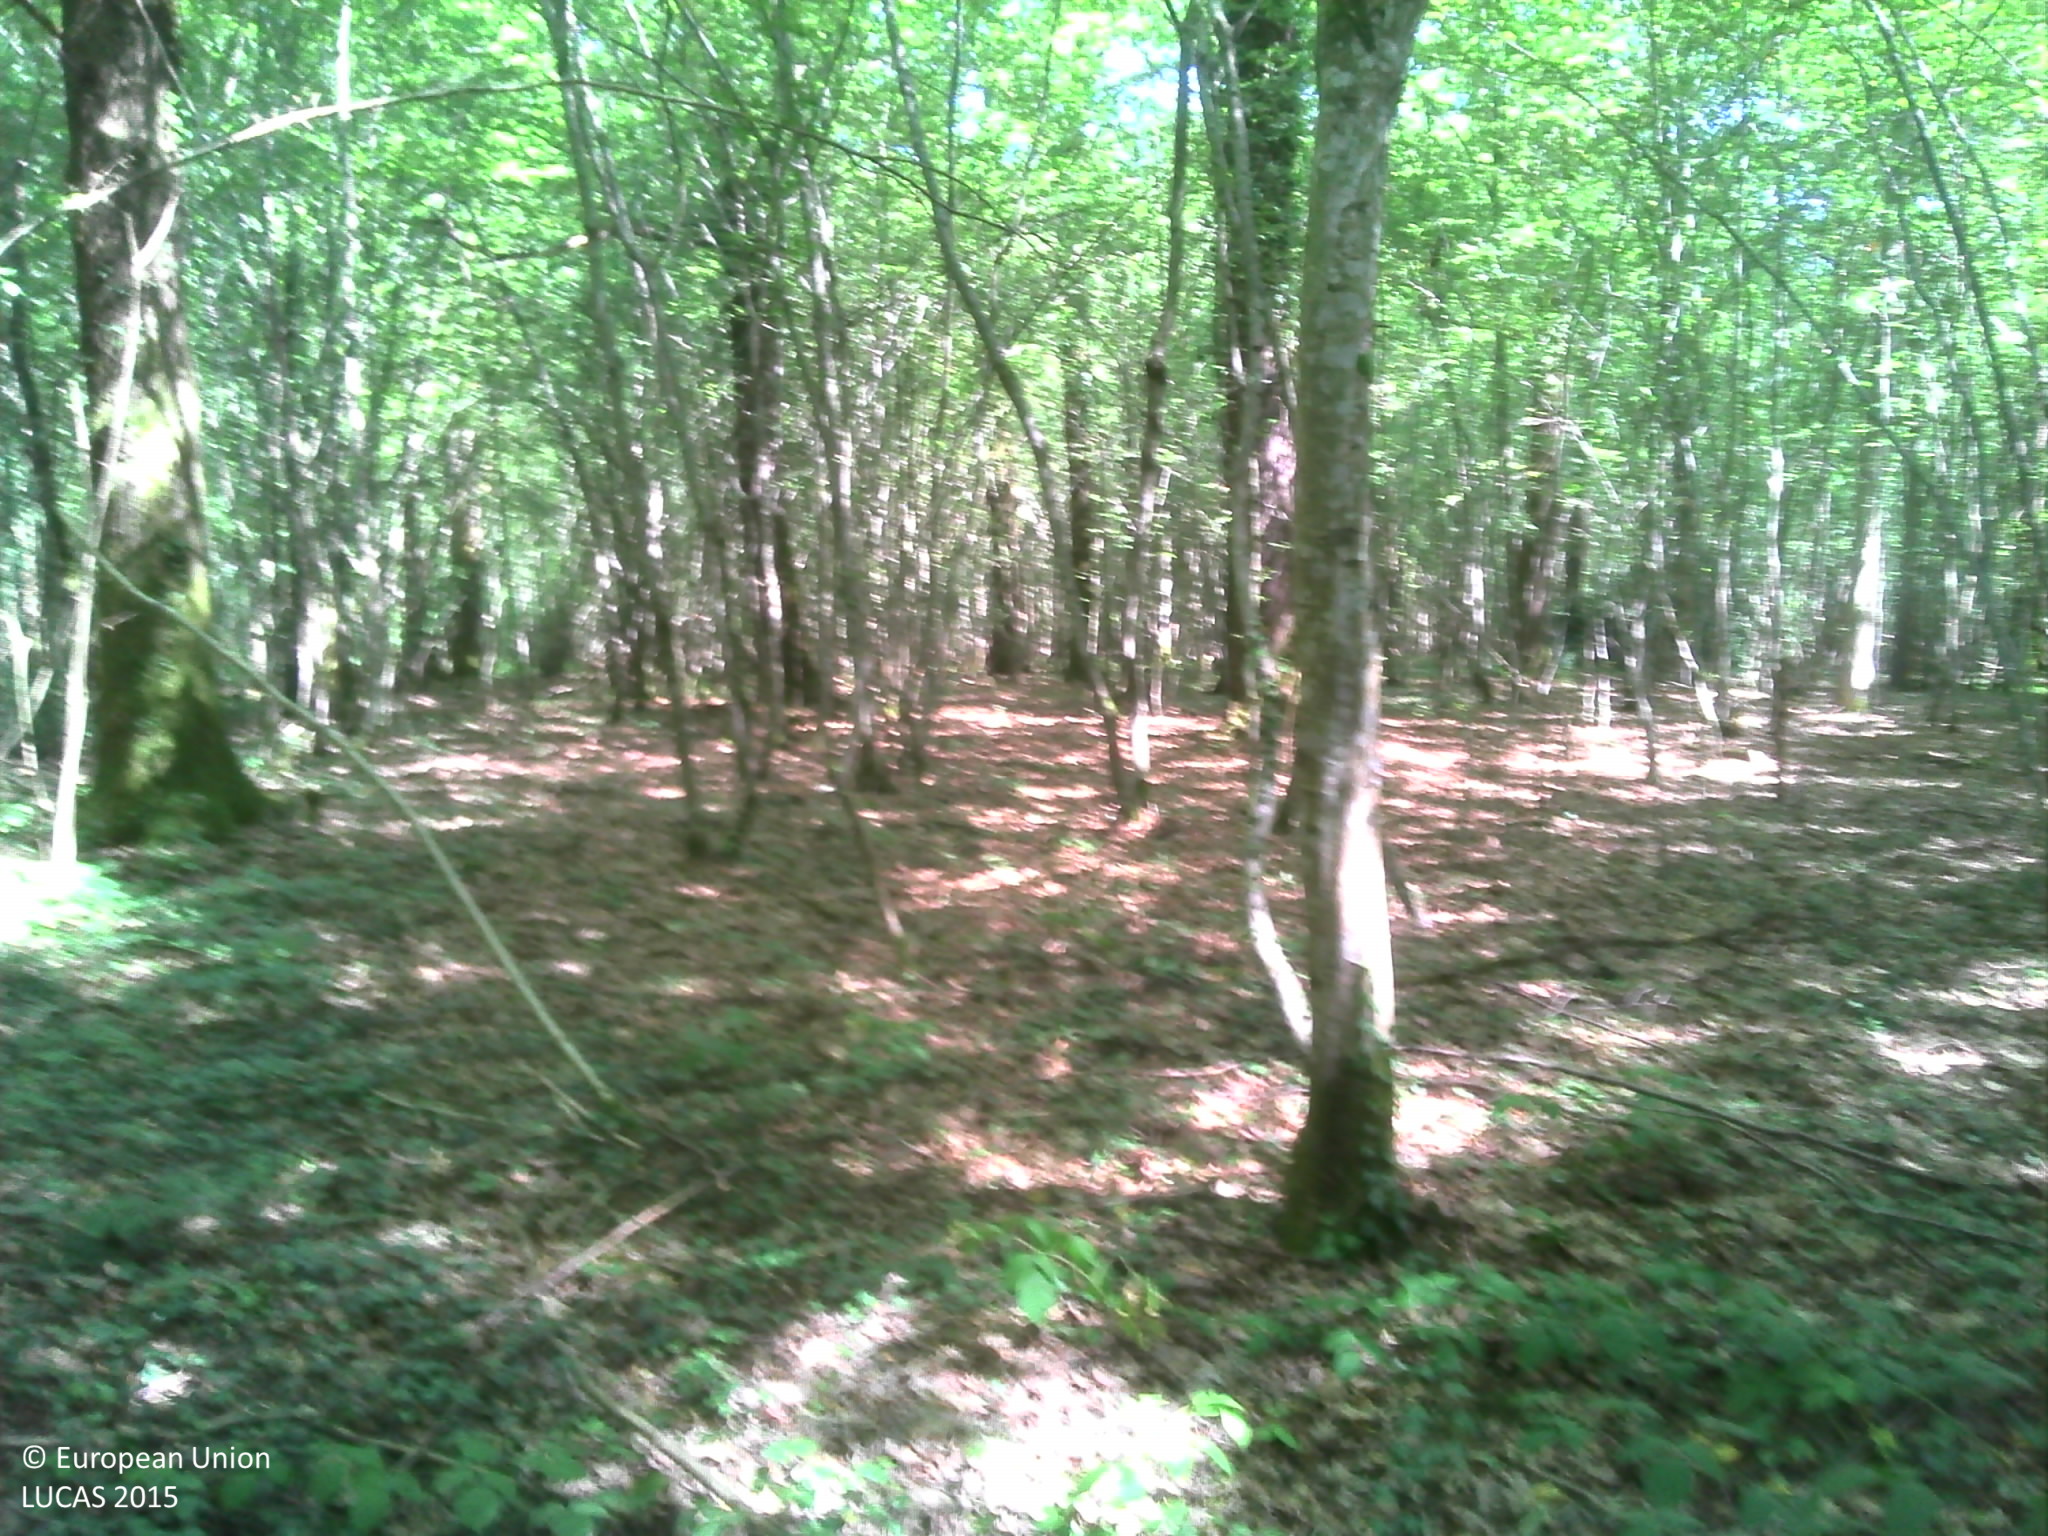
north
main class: Woodland
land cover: Broadleaved woodland
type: mesophytic deciduous forest
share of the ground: > 75 %
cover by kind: broadleaved forest trees 90 %, herbaceous plants 10 %
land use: Forestry
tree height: > 5 m
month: July
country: FR
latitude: 46.7773
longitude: 5.0378
